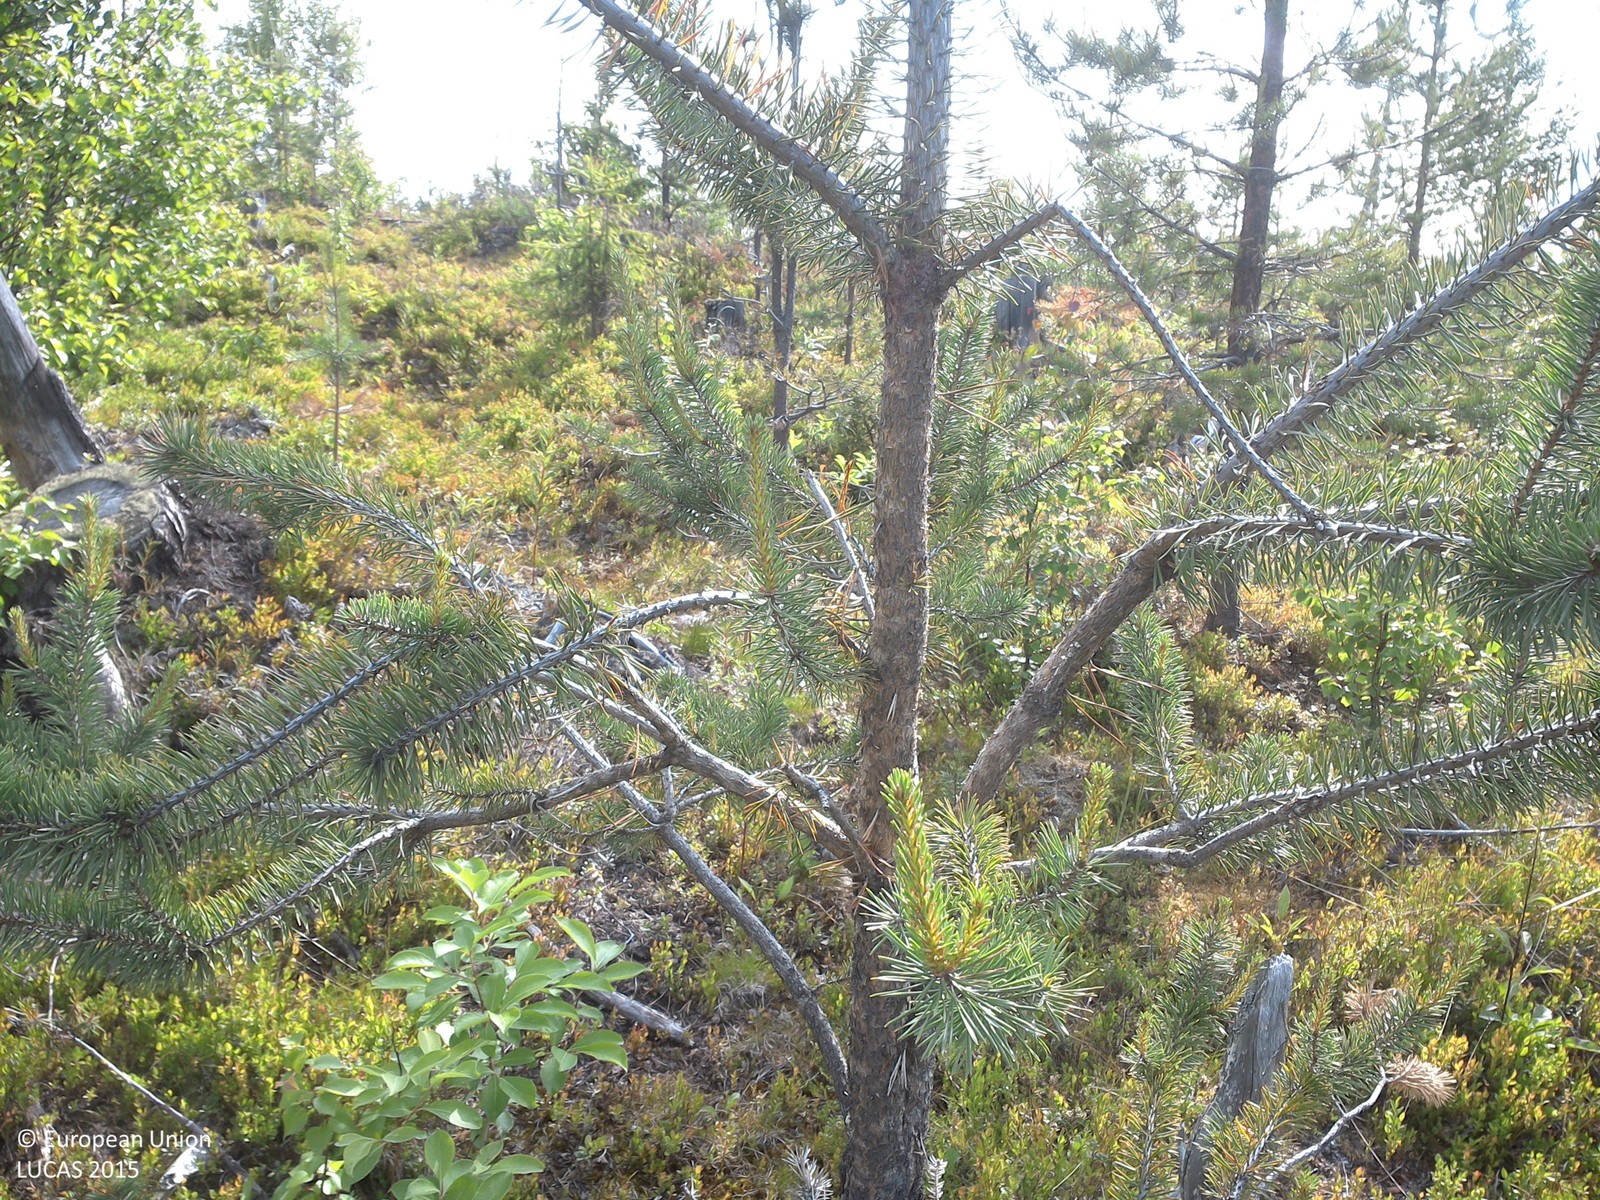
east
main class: Woodland
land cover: Pine dominated mixed woodland
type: boreal forest
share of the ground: 10 - 25 %
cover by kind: shrubs 65 %, coniferous forest trees 15 %, unconsolidated bare surface 10 %, broadleaved forest trees 5 %, lichens and mosses 5 %
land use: Forestry
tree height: < 5 m
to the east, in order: Pine dominated mixed woodland
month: July
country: SE
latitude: 67.1942
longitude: 23.1707
